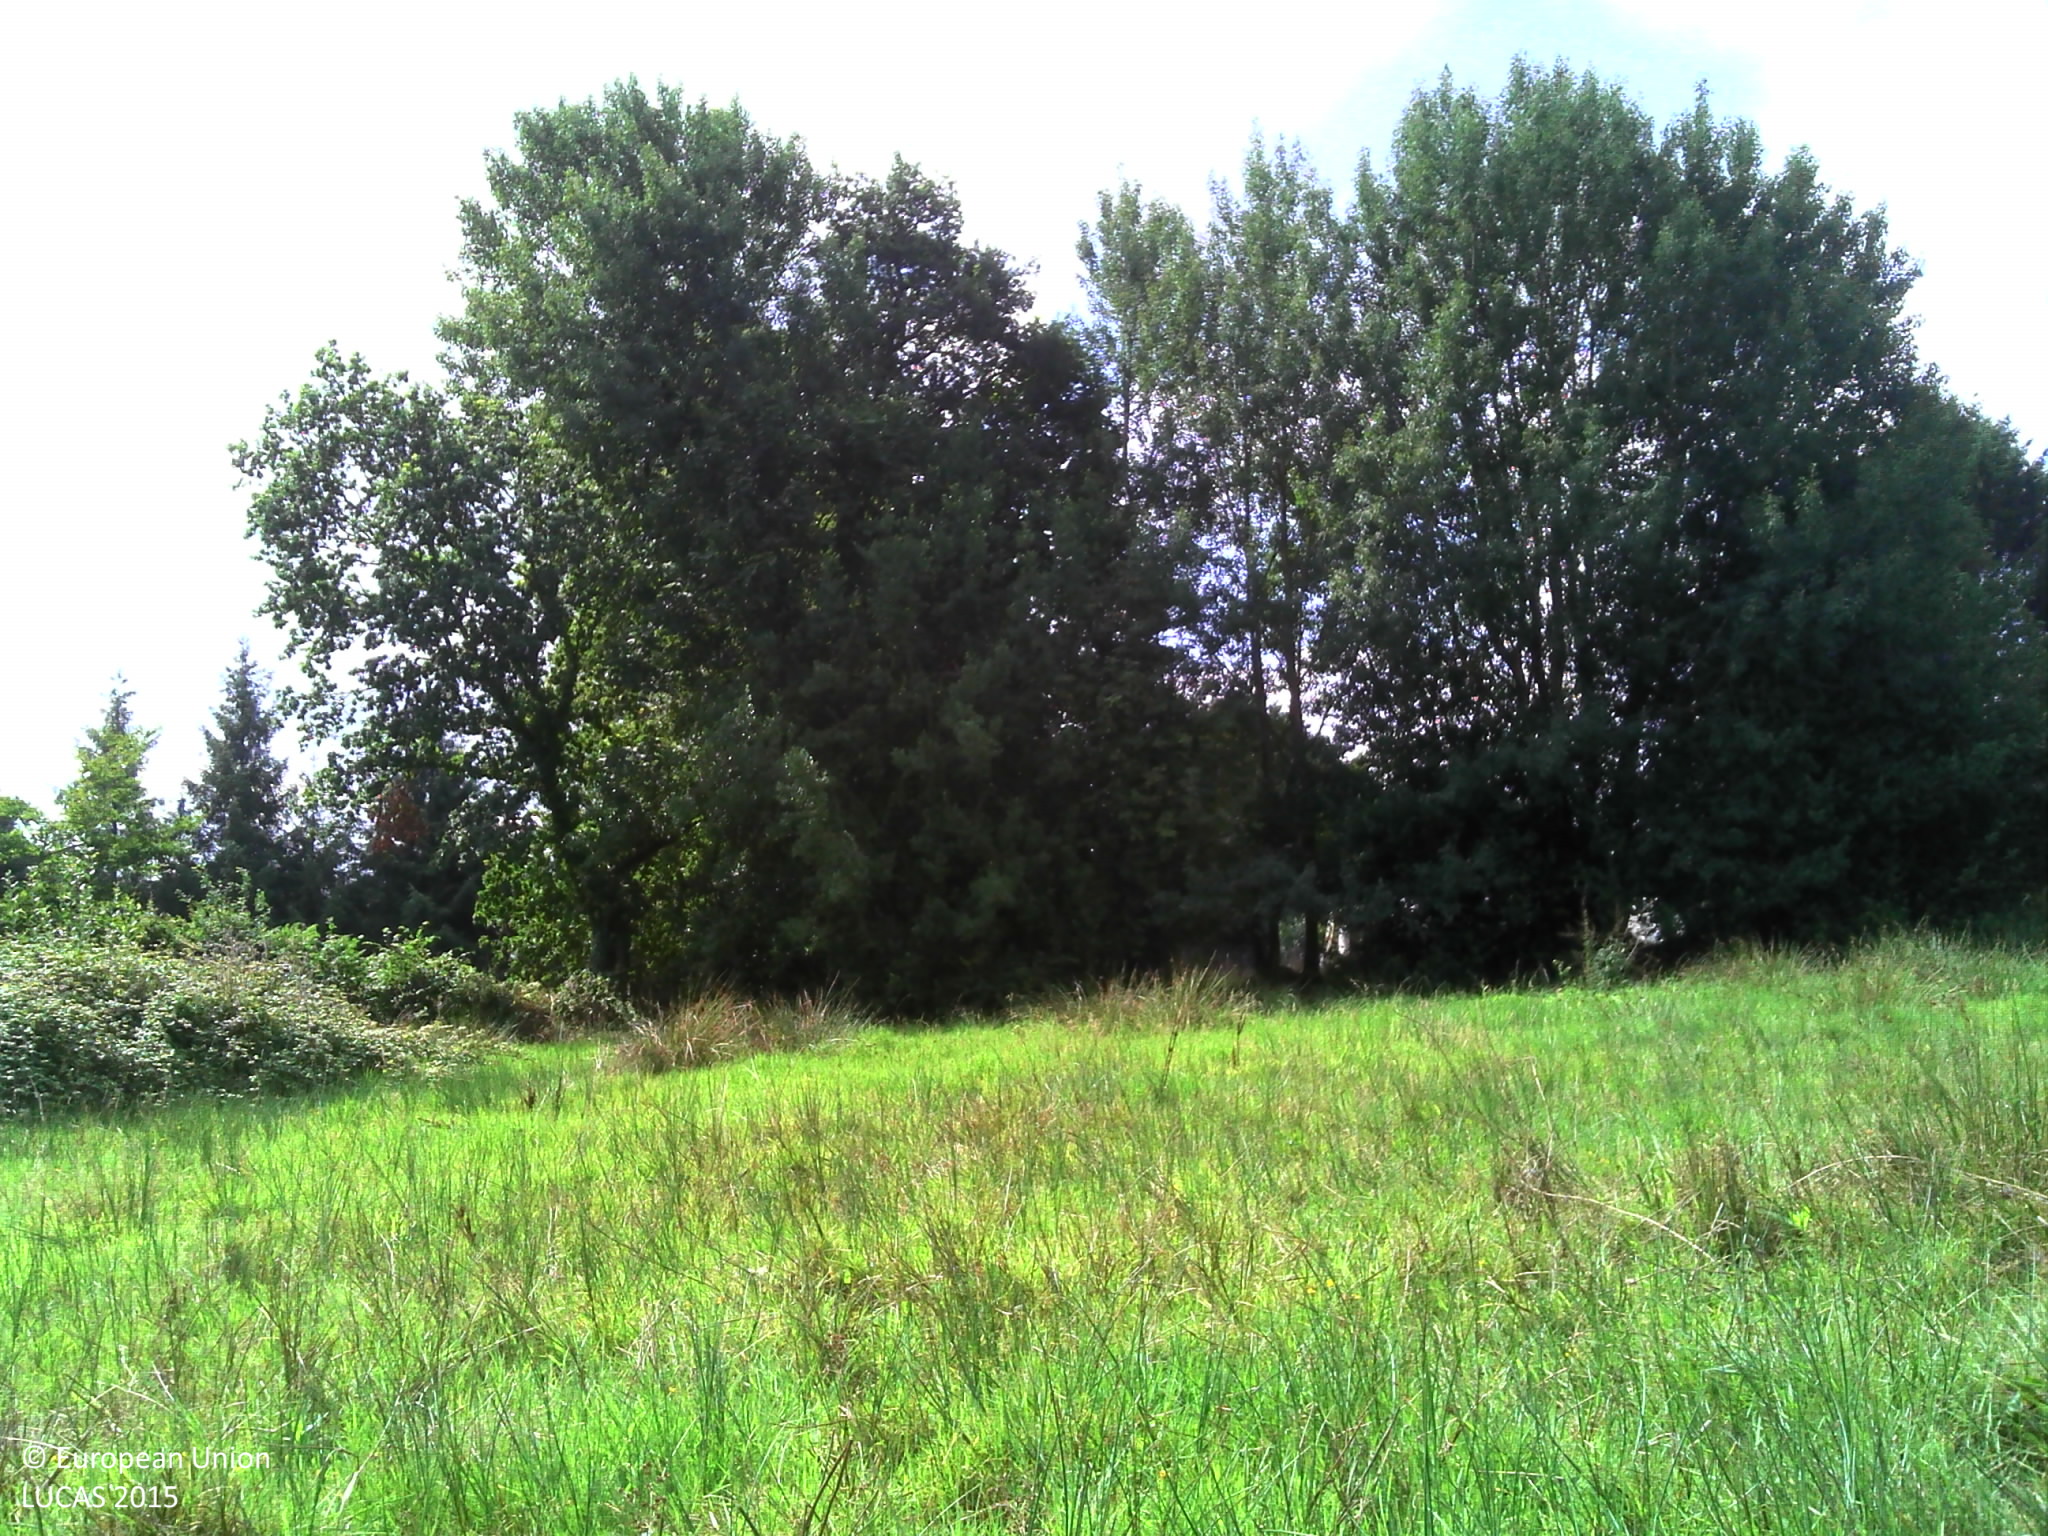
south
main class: Grassland
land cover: Grassland without tree/shrub cover
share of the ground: > 75 %
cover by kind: herbaceous plants 100 %
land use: Agriculture (excluding fallow land and kitchen gardens)
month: August
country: FR
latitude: 48.5941
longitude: -3.1850
